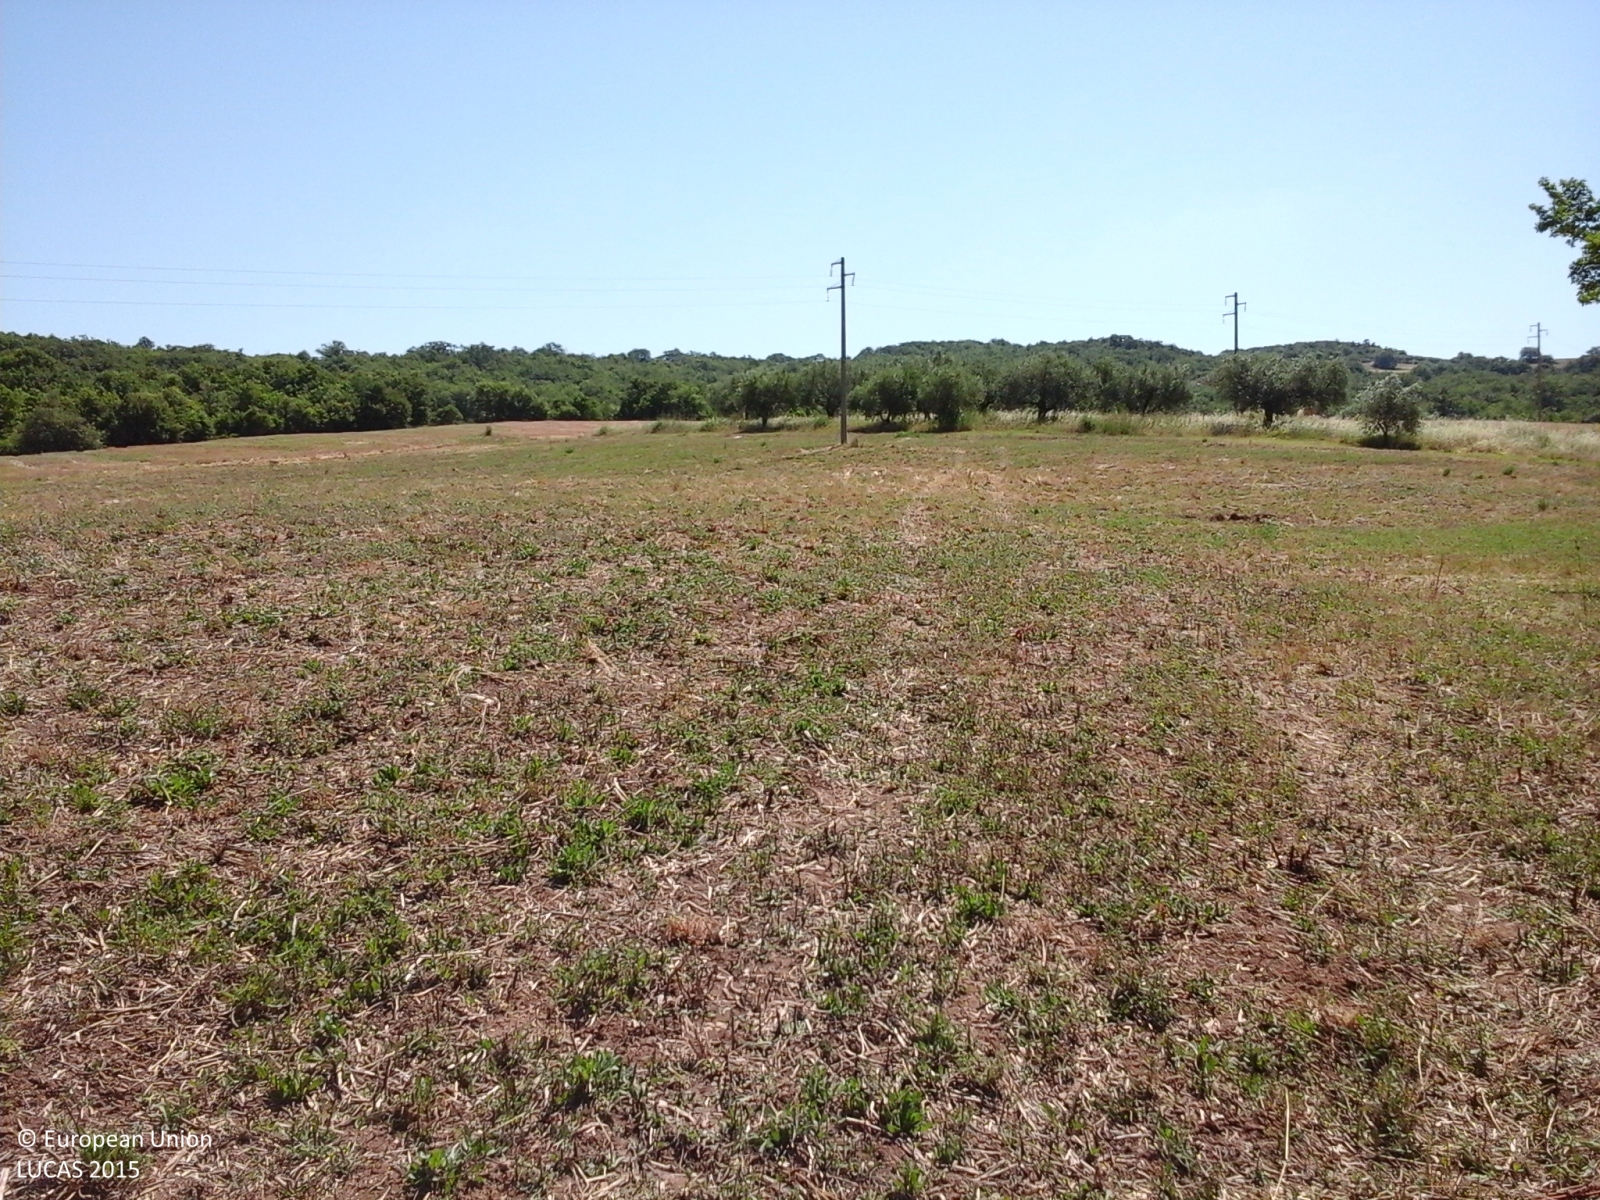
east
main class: Cropland
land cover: Lucerne
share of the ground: > 75 %
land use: Agriculture (excluding fallow land and kitchen gardens)
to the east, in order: Lucerne; Electric lines; Lucerne; Olive groves; Durum wheat
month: July
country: IT
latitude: 41.7280
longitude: 14.7568
